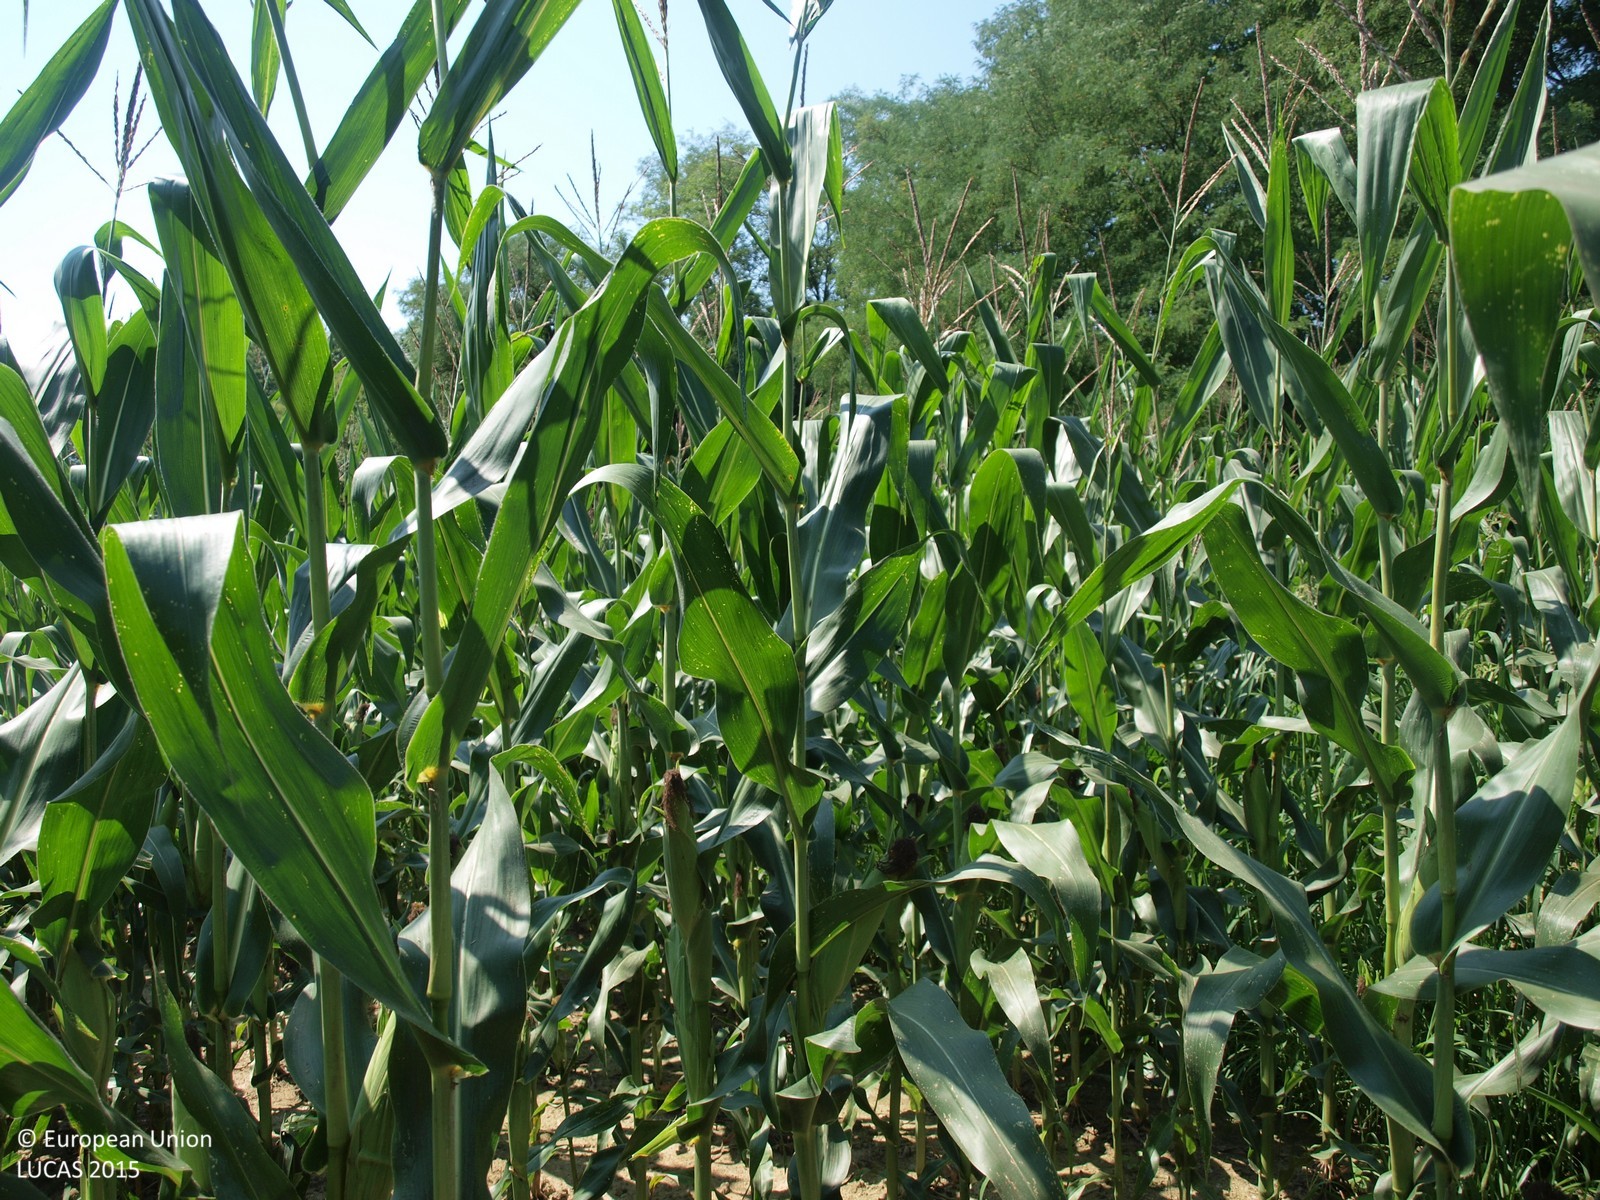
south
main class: Cropland
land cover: Maize
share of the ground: > 75 %
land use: Agriculture (excluding fallow land and kitchen gardens)
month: August
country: HR
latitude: 45.8968
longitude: 16.5598
